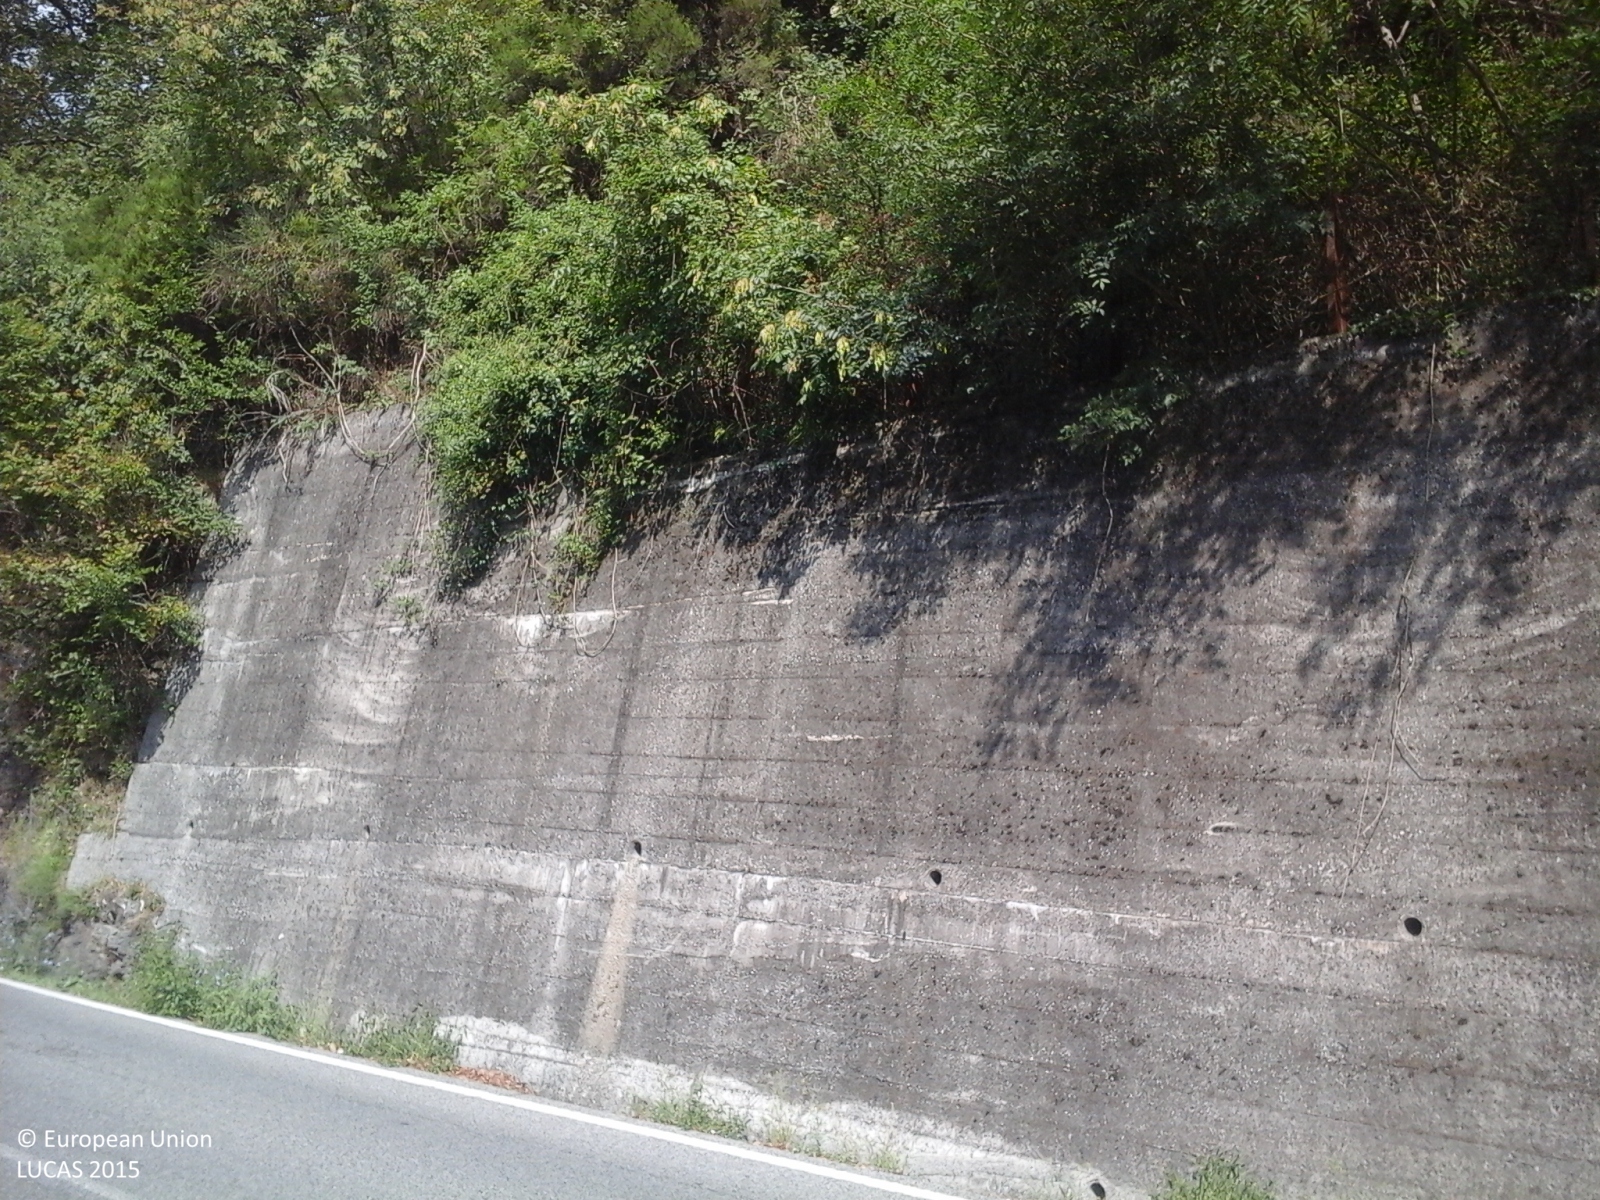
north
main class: Woodland
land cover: Broadleaved woodland
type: thermophilous deciduous forest
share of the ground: > 75 %
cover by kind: broadleaved forest trees 100 %
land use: Semi-natural and natural areas not in use
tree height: > 5 m
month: September
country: IT
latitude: 44.4373
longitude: 9.1601
